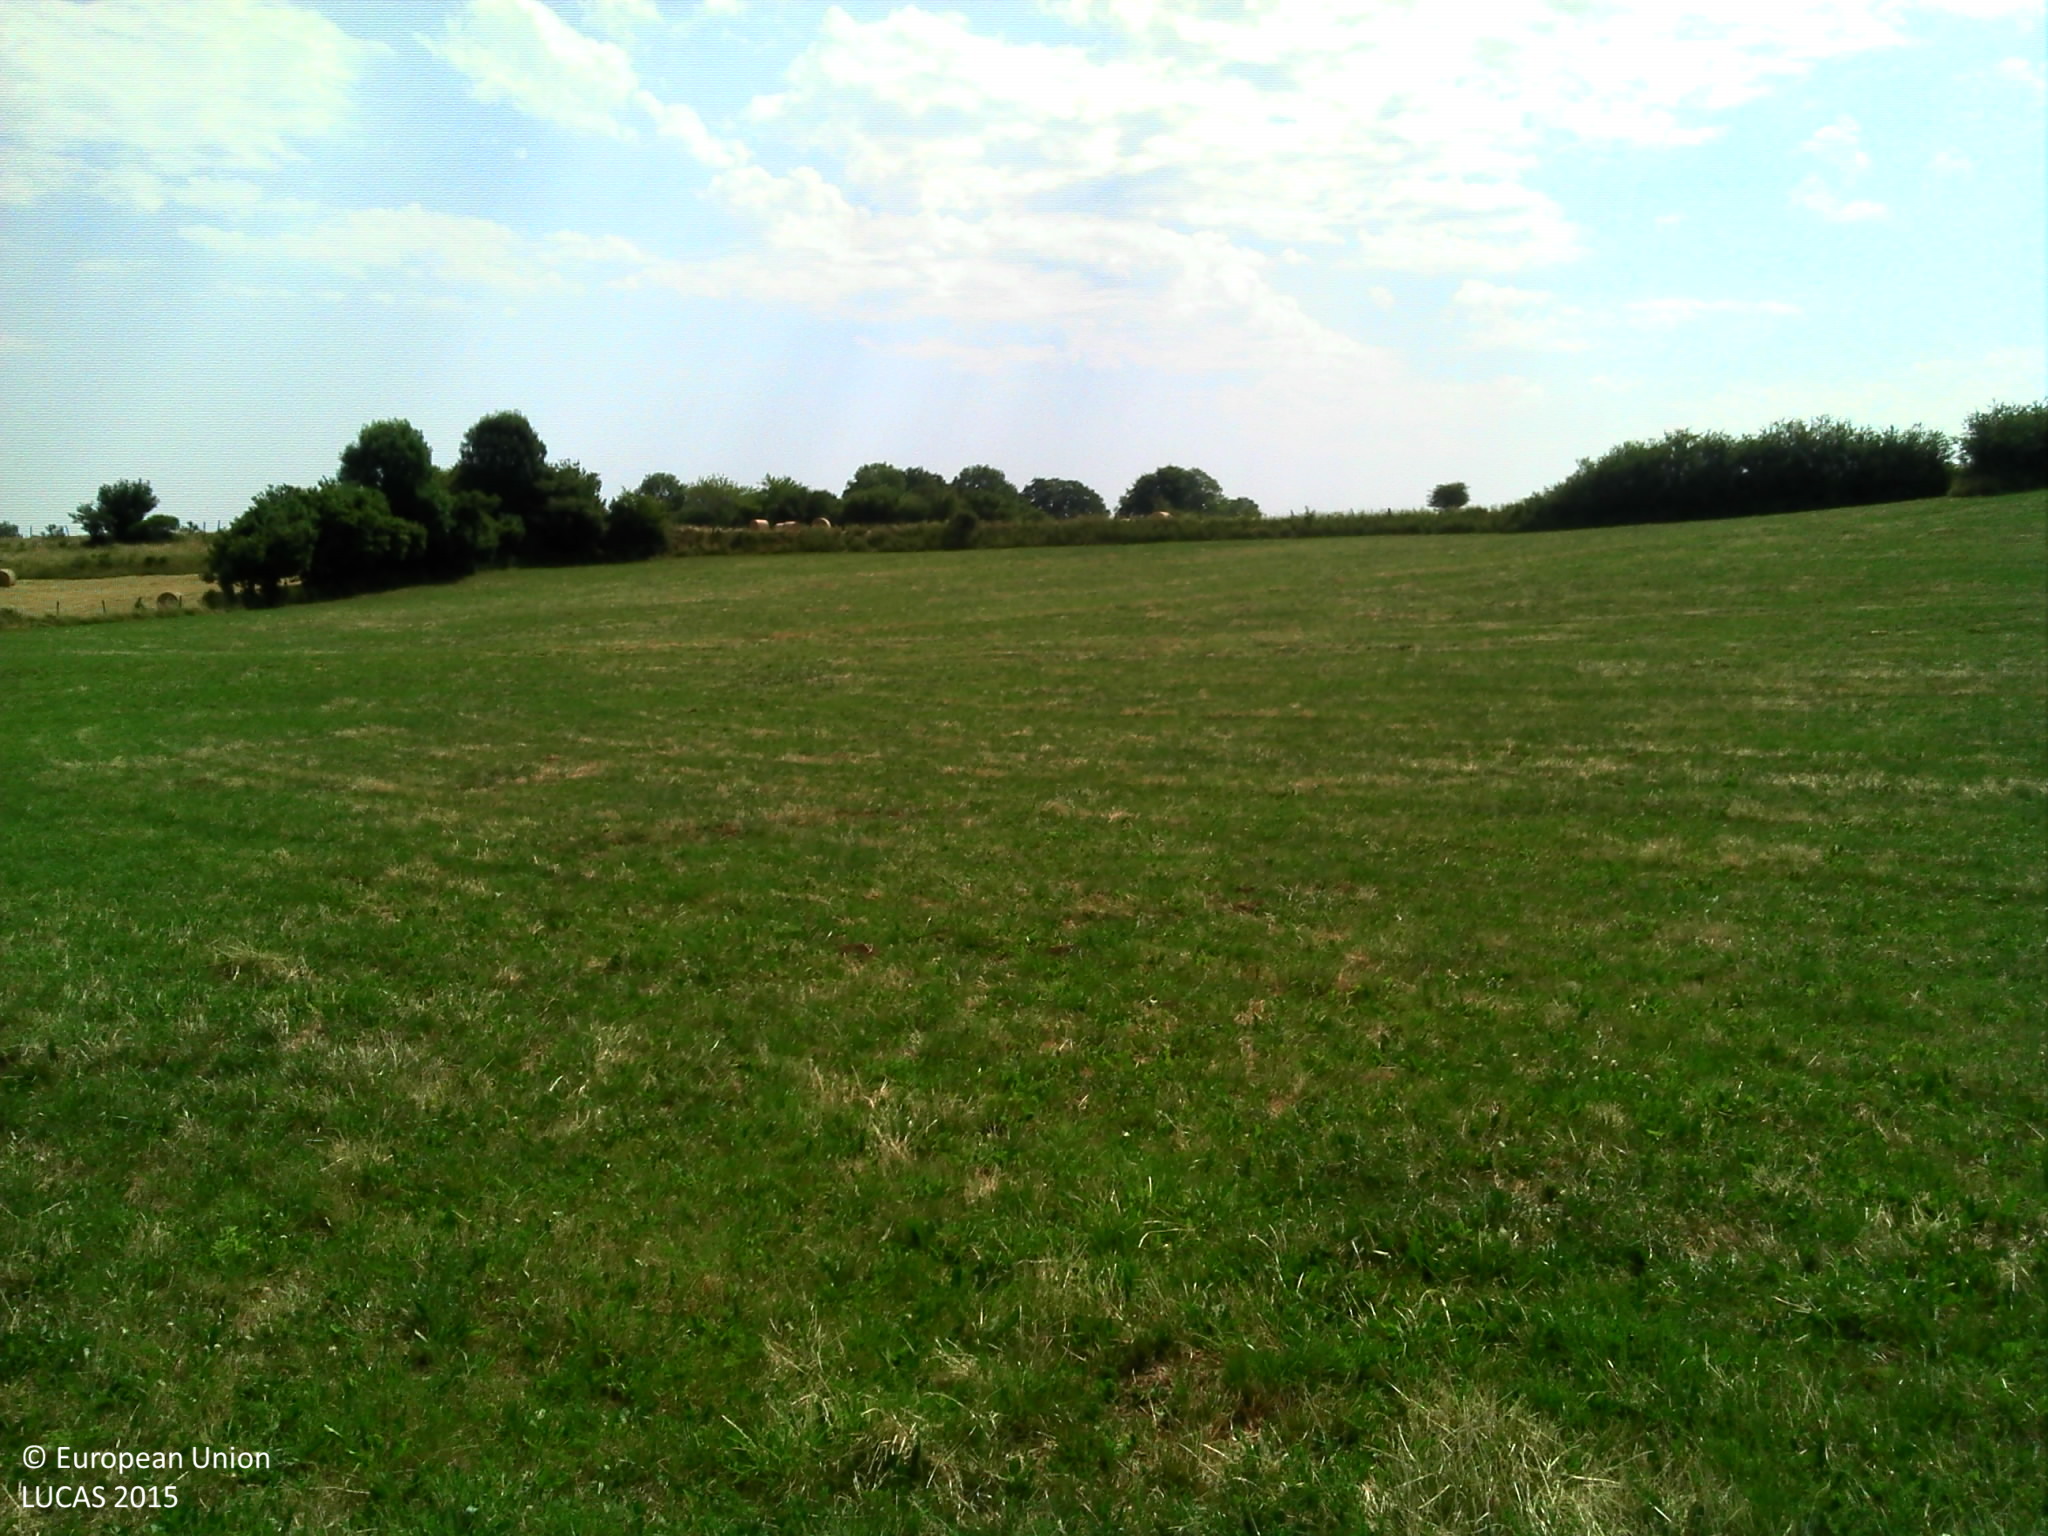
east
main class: Grassland
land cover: Grassland without tree/shrub cover
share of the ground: > 75 %
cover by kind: herbaceous plants 100 %
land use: Agriculture (excluding fallow land and kitchen gardens)
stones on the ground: < 10 %
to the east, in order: Grassland without tree/shrub cover; Spontaneously vegetated surfaces; Fences; Grassland without tree/shrub cover; Fences; Single bushes/trees; Grassland without tree/shrub cover
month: July
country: FR
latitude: 44.8691
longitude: 2.9271
